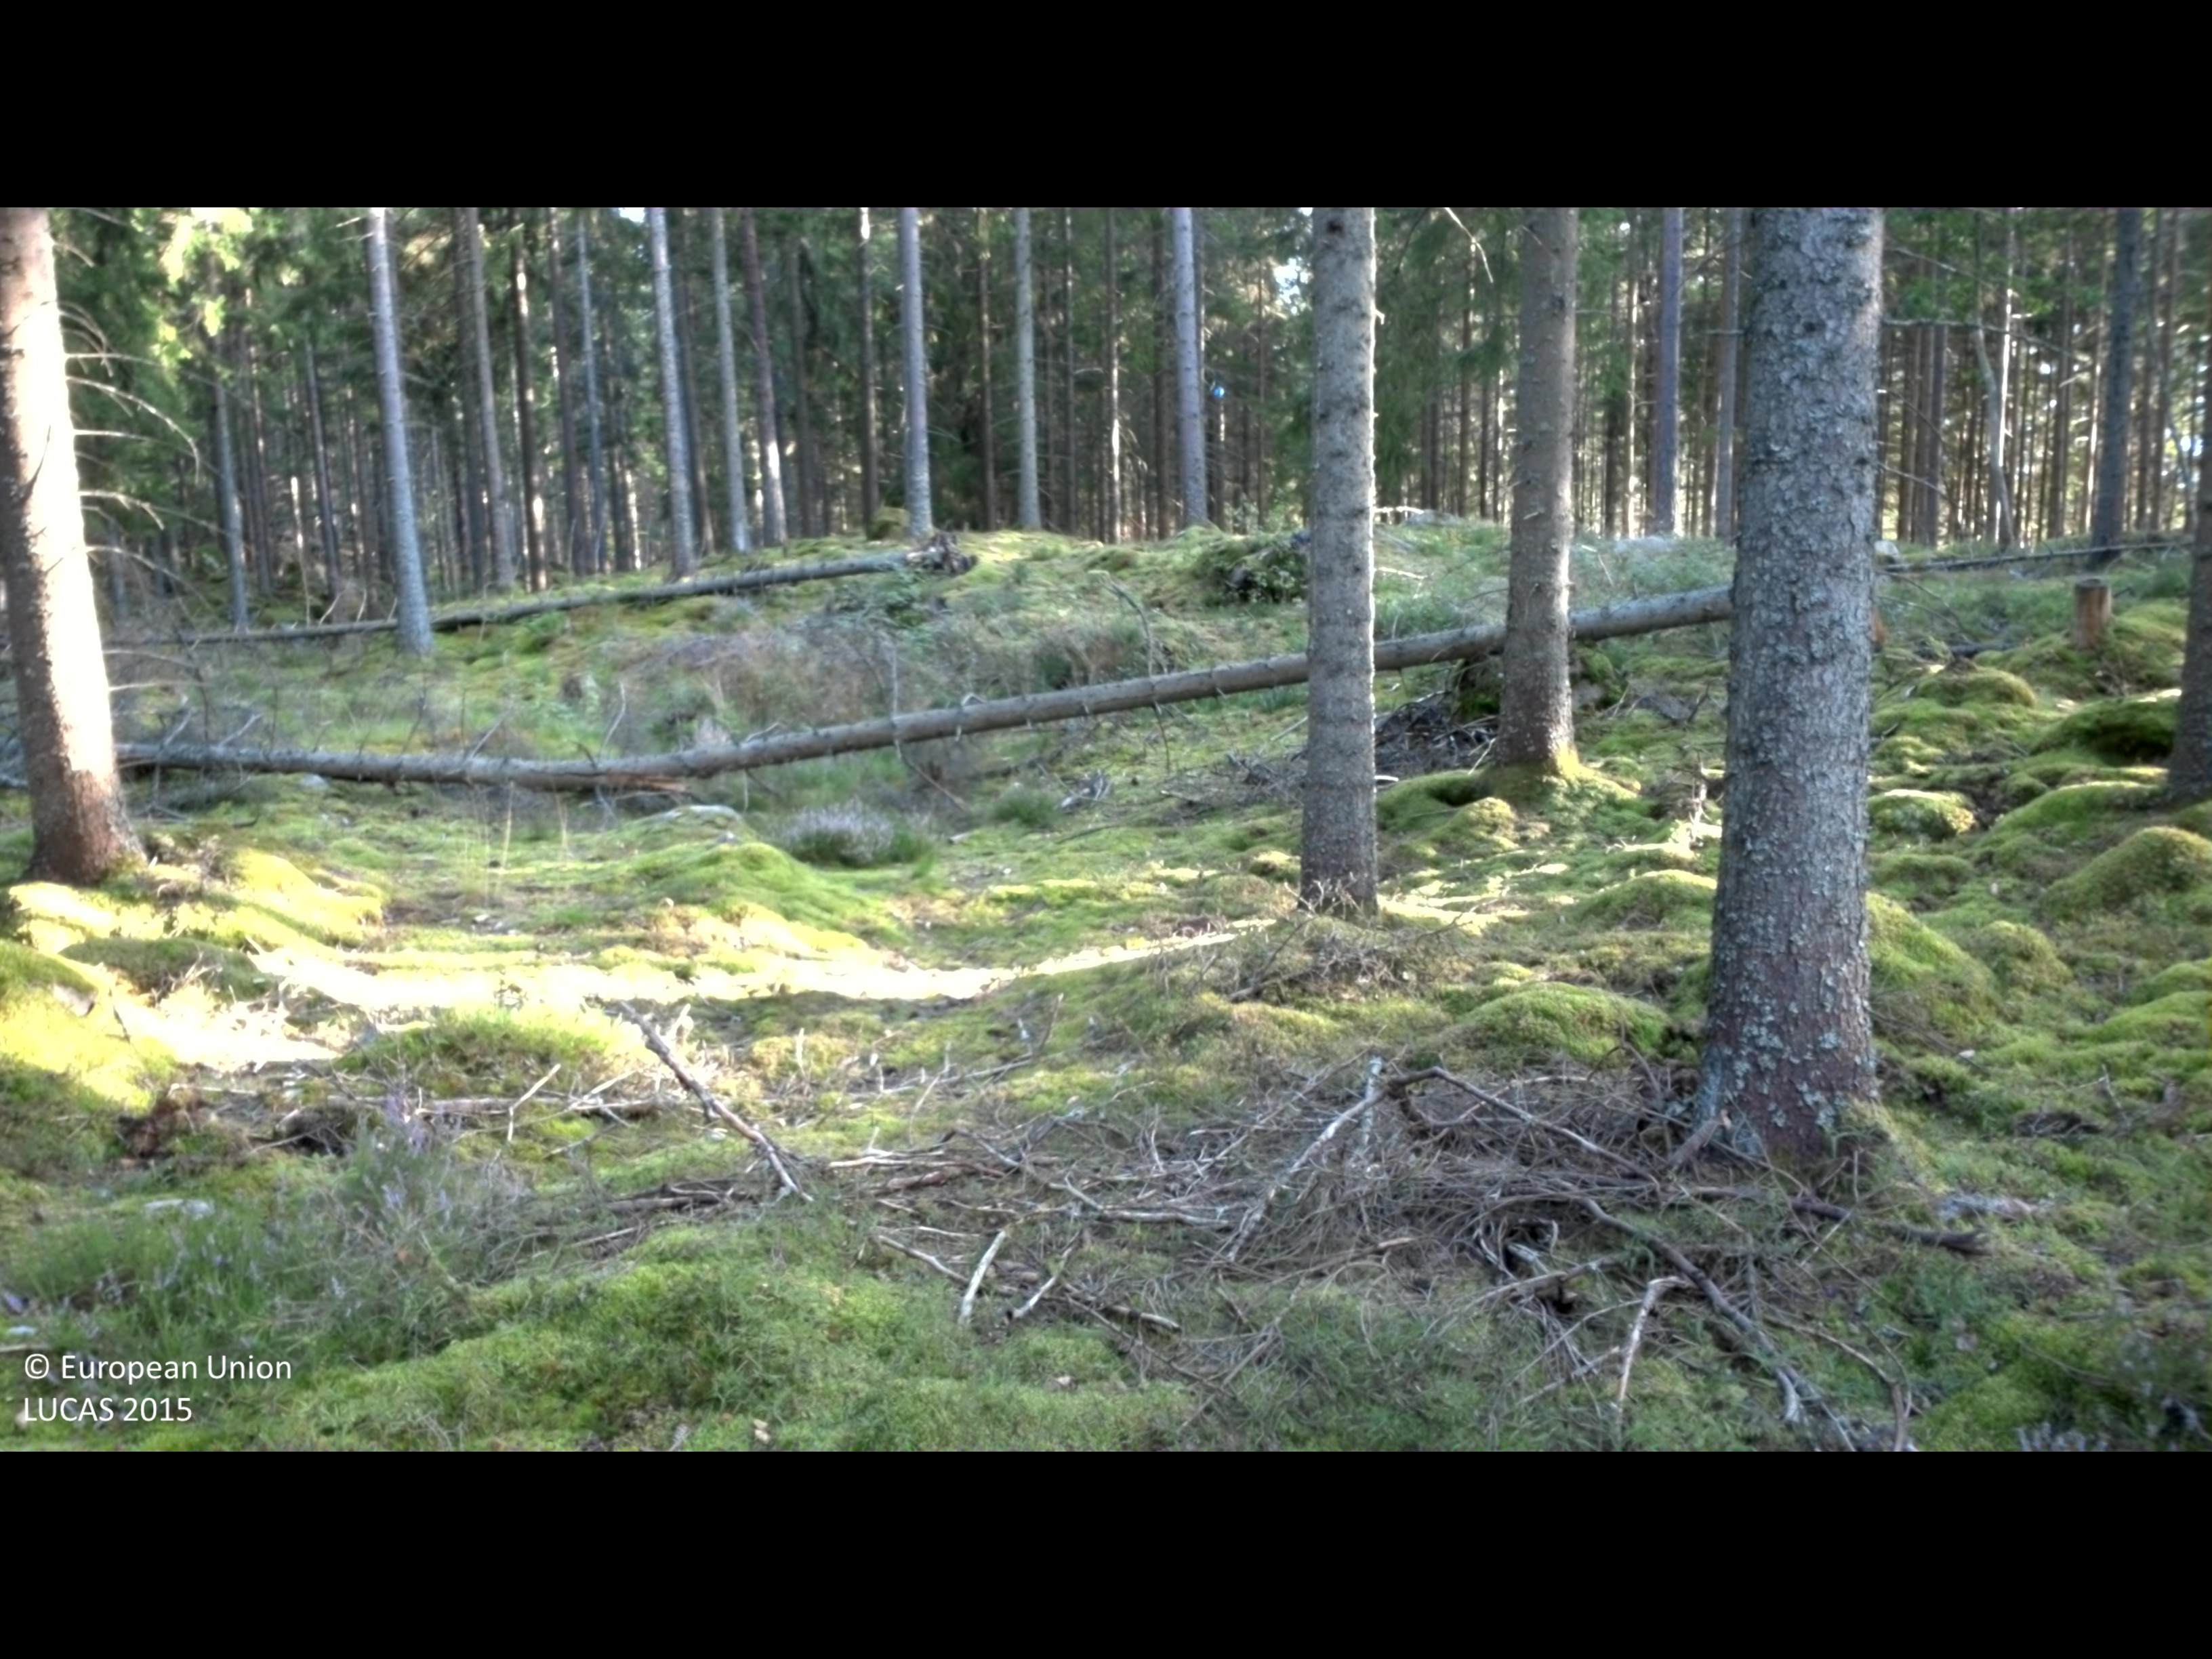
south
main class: Woodland
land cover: Spruce dominated coniferous woodland
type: boreal forest
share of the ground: 50 - 75 %
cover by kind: coniferous forest trees 55 %, lichens and mosses 35 %, shrubs 10 %
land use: Forestry
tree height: > 5 m
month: August
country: SE
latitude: 56.3449
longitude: 14.4470
